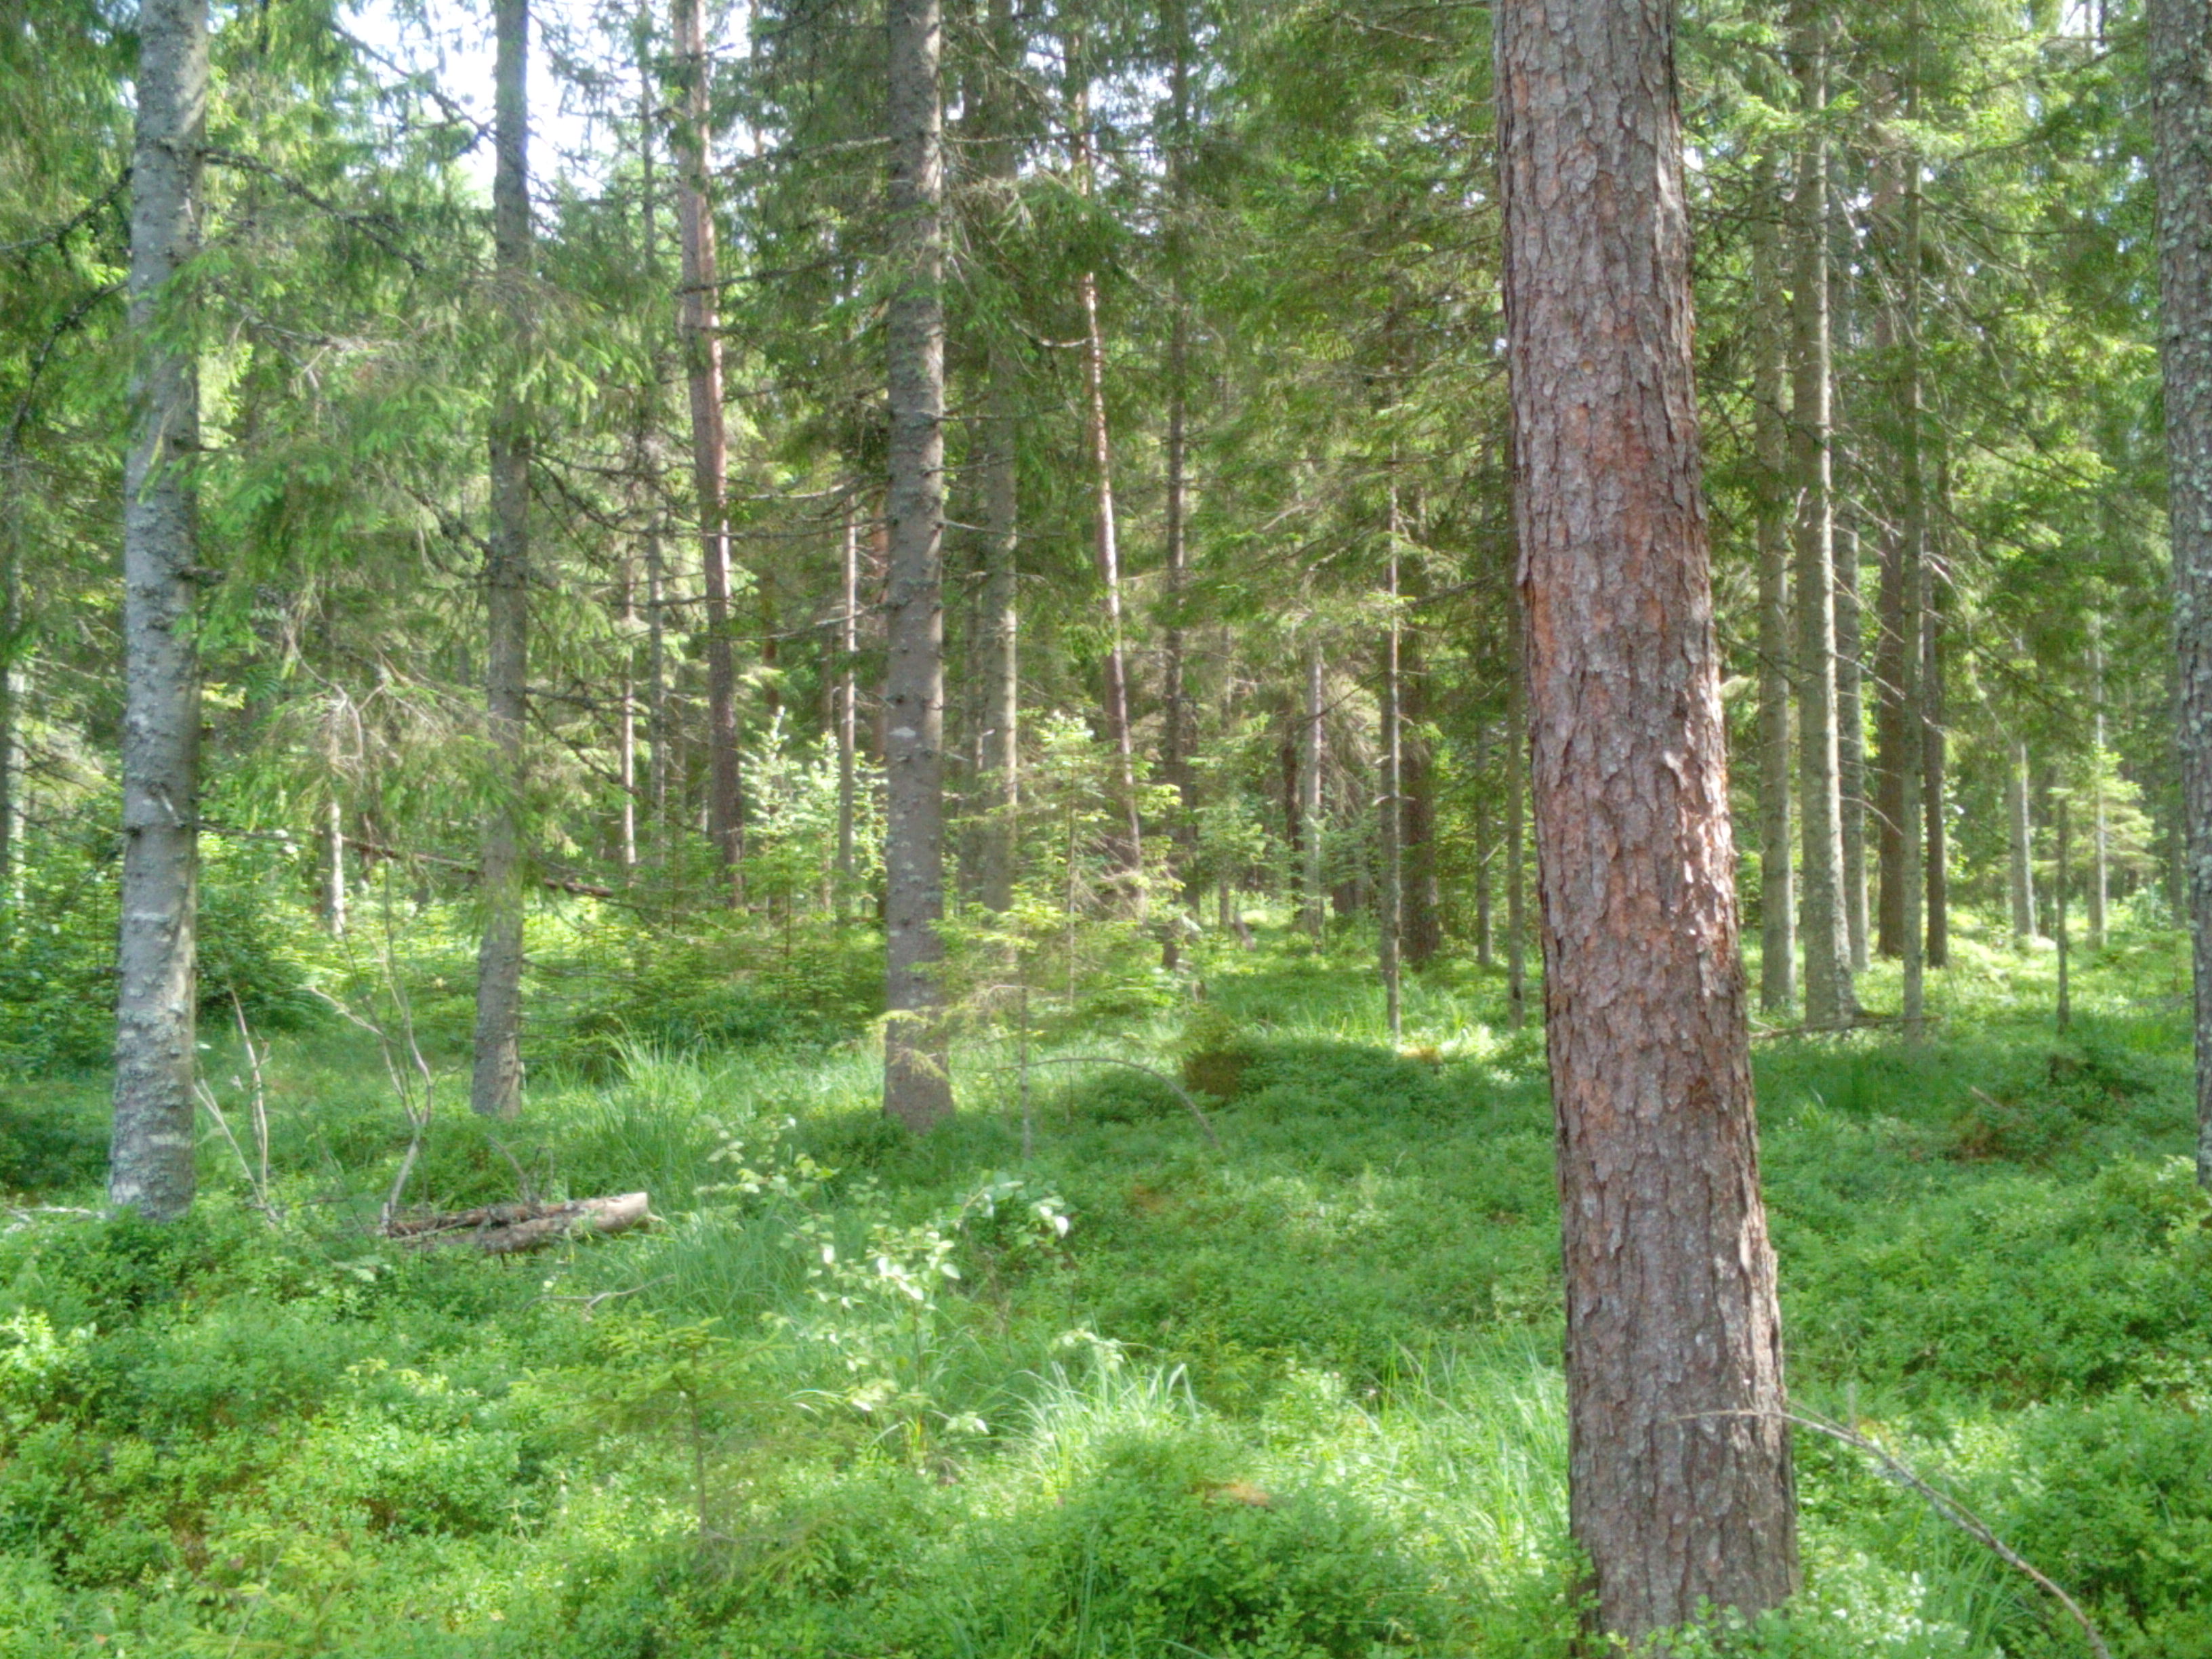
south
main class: Woodland
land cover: Other coniferous woodland
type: hemiboreal forest and nemoral coniferous forest and mixed broadleaved-coniferous forest
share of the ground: > 75 %
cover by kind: coniferous forest trees 75 %, herbaceous plants 15 %, broadleaved forest trees 5 %, lichens and mosses 5 %
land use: Forestry
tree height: > 5 m
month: July
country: LV
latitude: 56.9913
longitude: 22.3474
